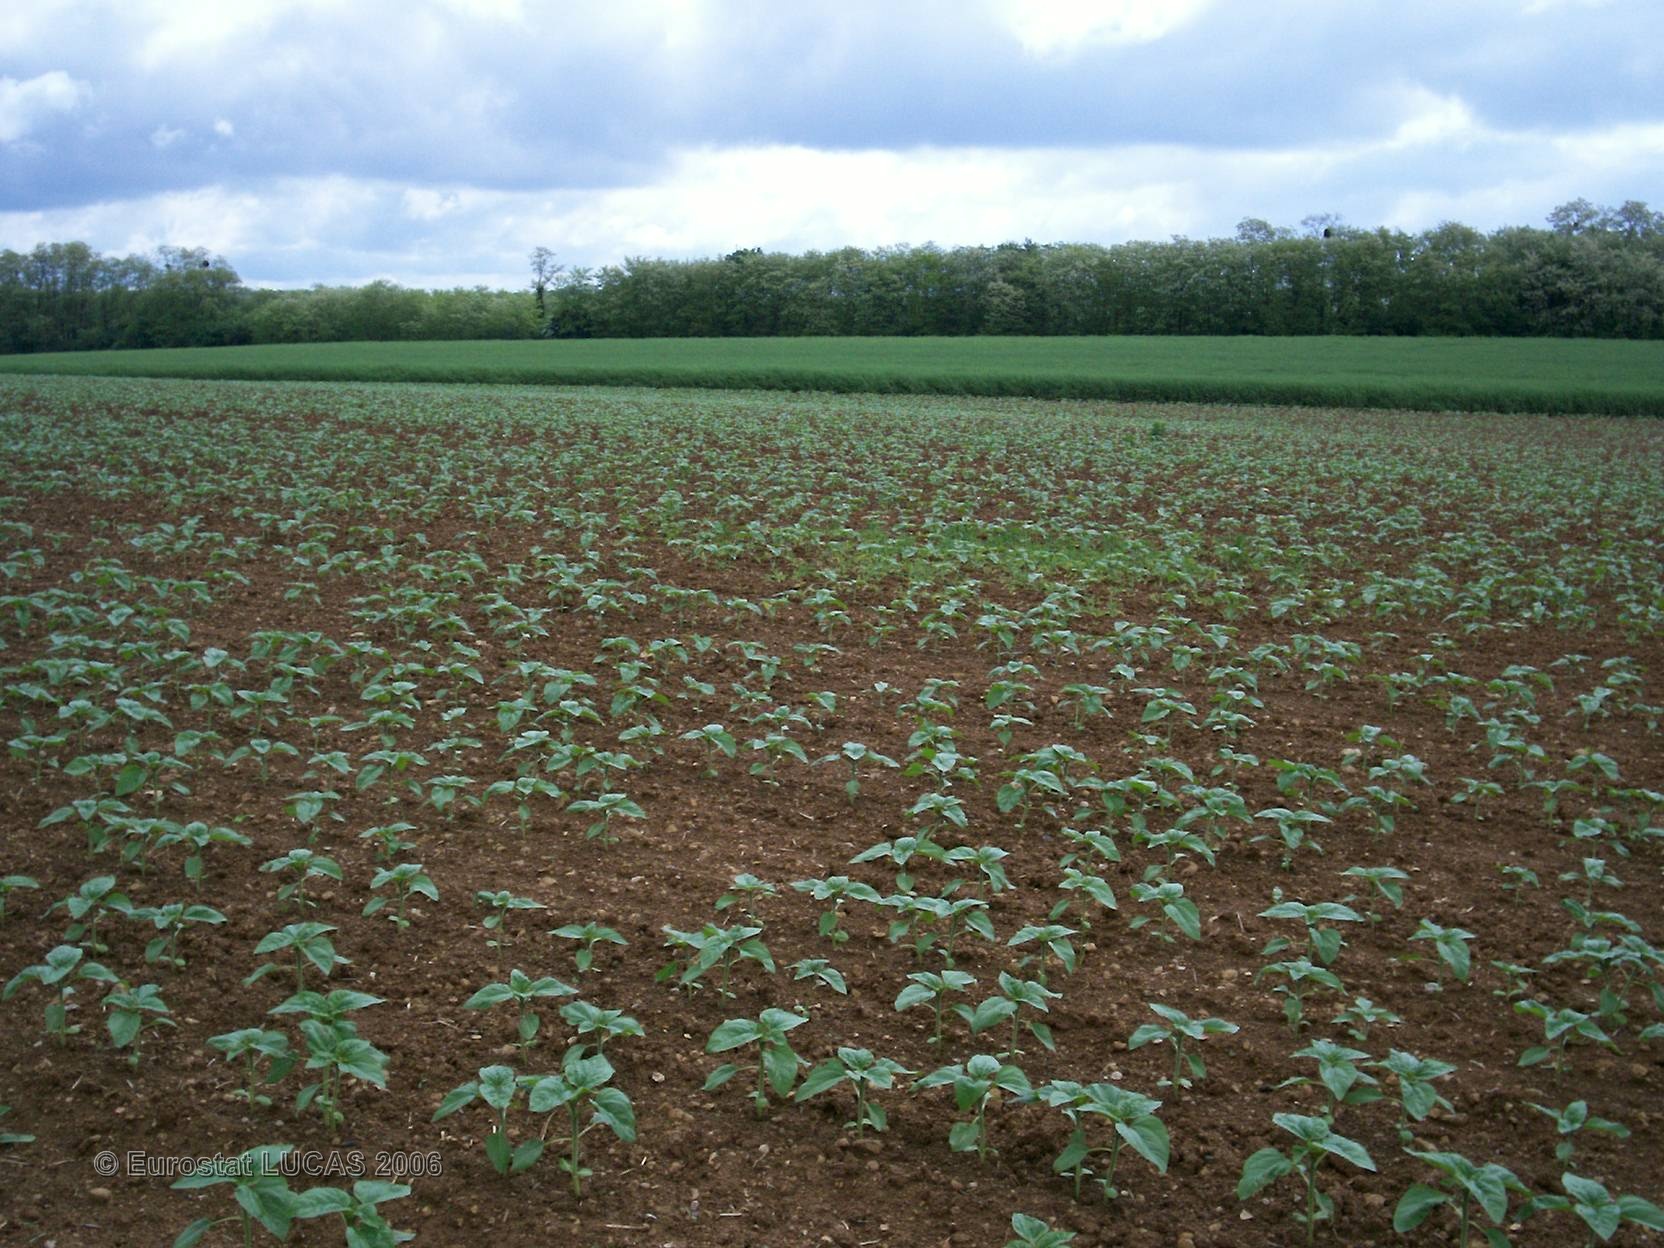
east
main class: Cropland
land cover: Sunflower
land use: Agriculture (excluding fallow land and kitchen gardens)
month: May
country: FR
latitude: 48.2687
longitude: 4.5413
